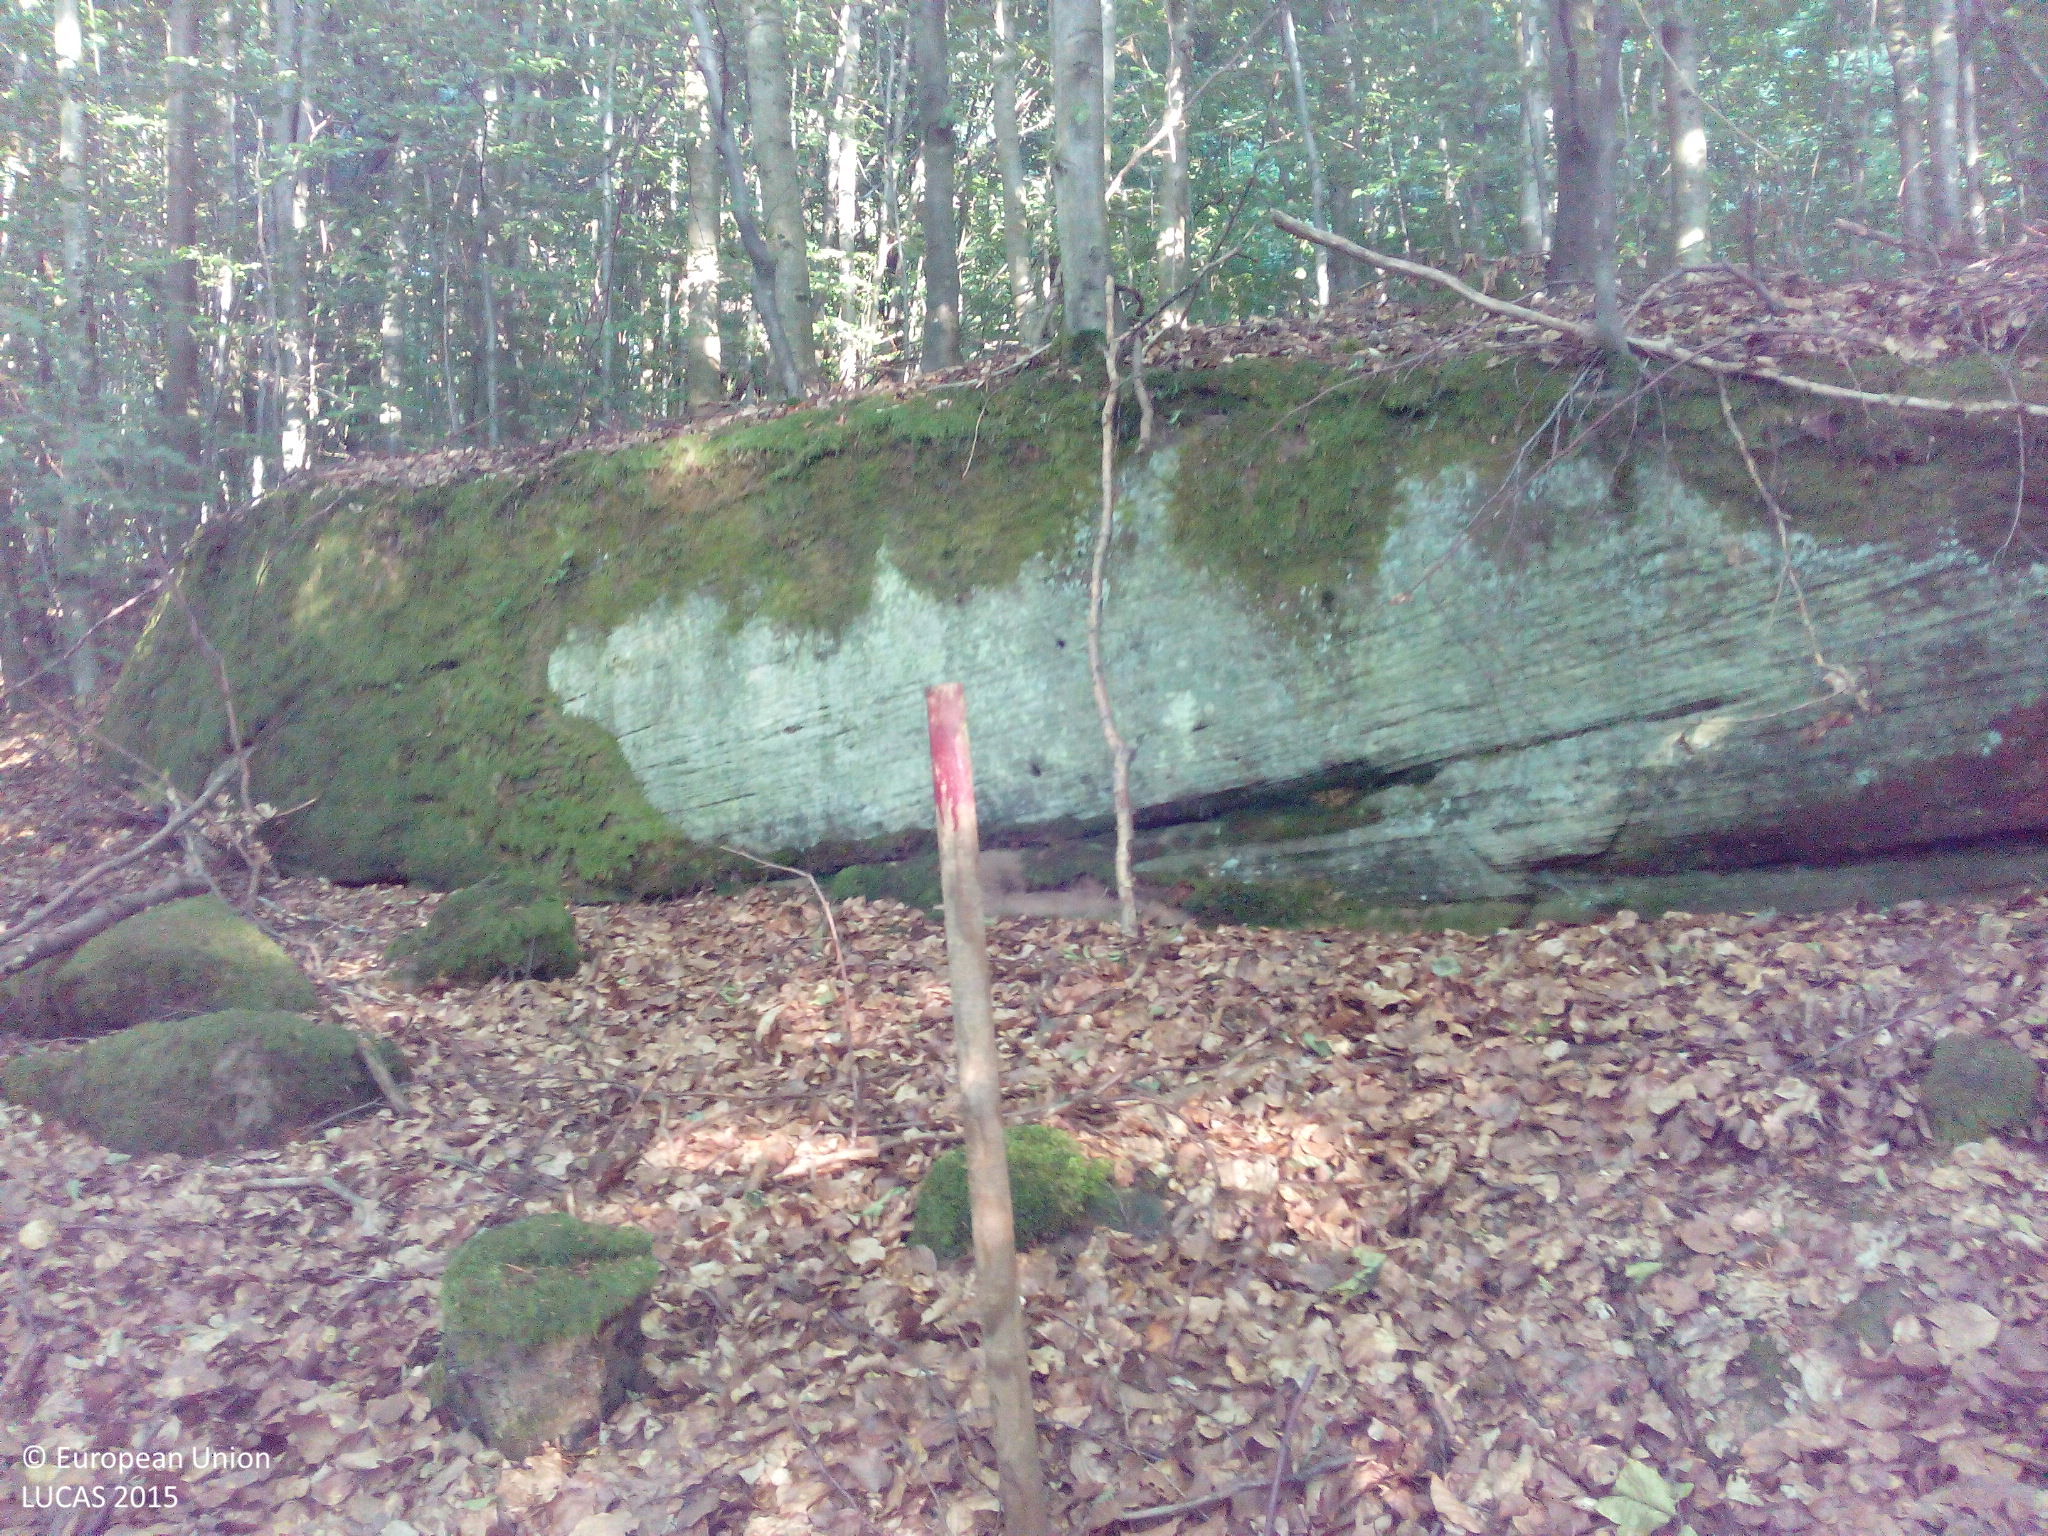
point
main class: Woodland
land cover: Broadleaved woodland
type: beech forest
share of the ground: > 75 %
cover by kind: broadleaved forest trees 90 %, unconsolidated bare surface 10 %
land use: Forestry
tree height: > 5 m
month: July
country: DE
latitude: 49.1514
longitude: 7.6012
